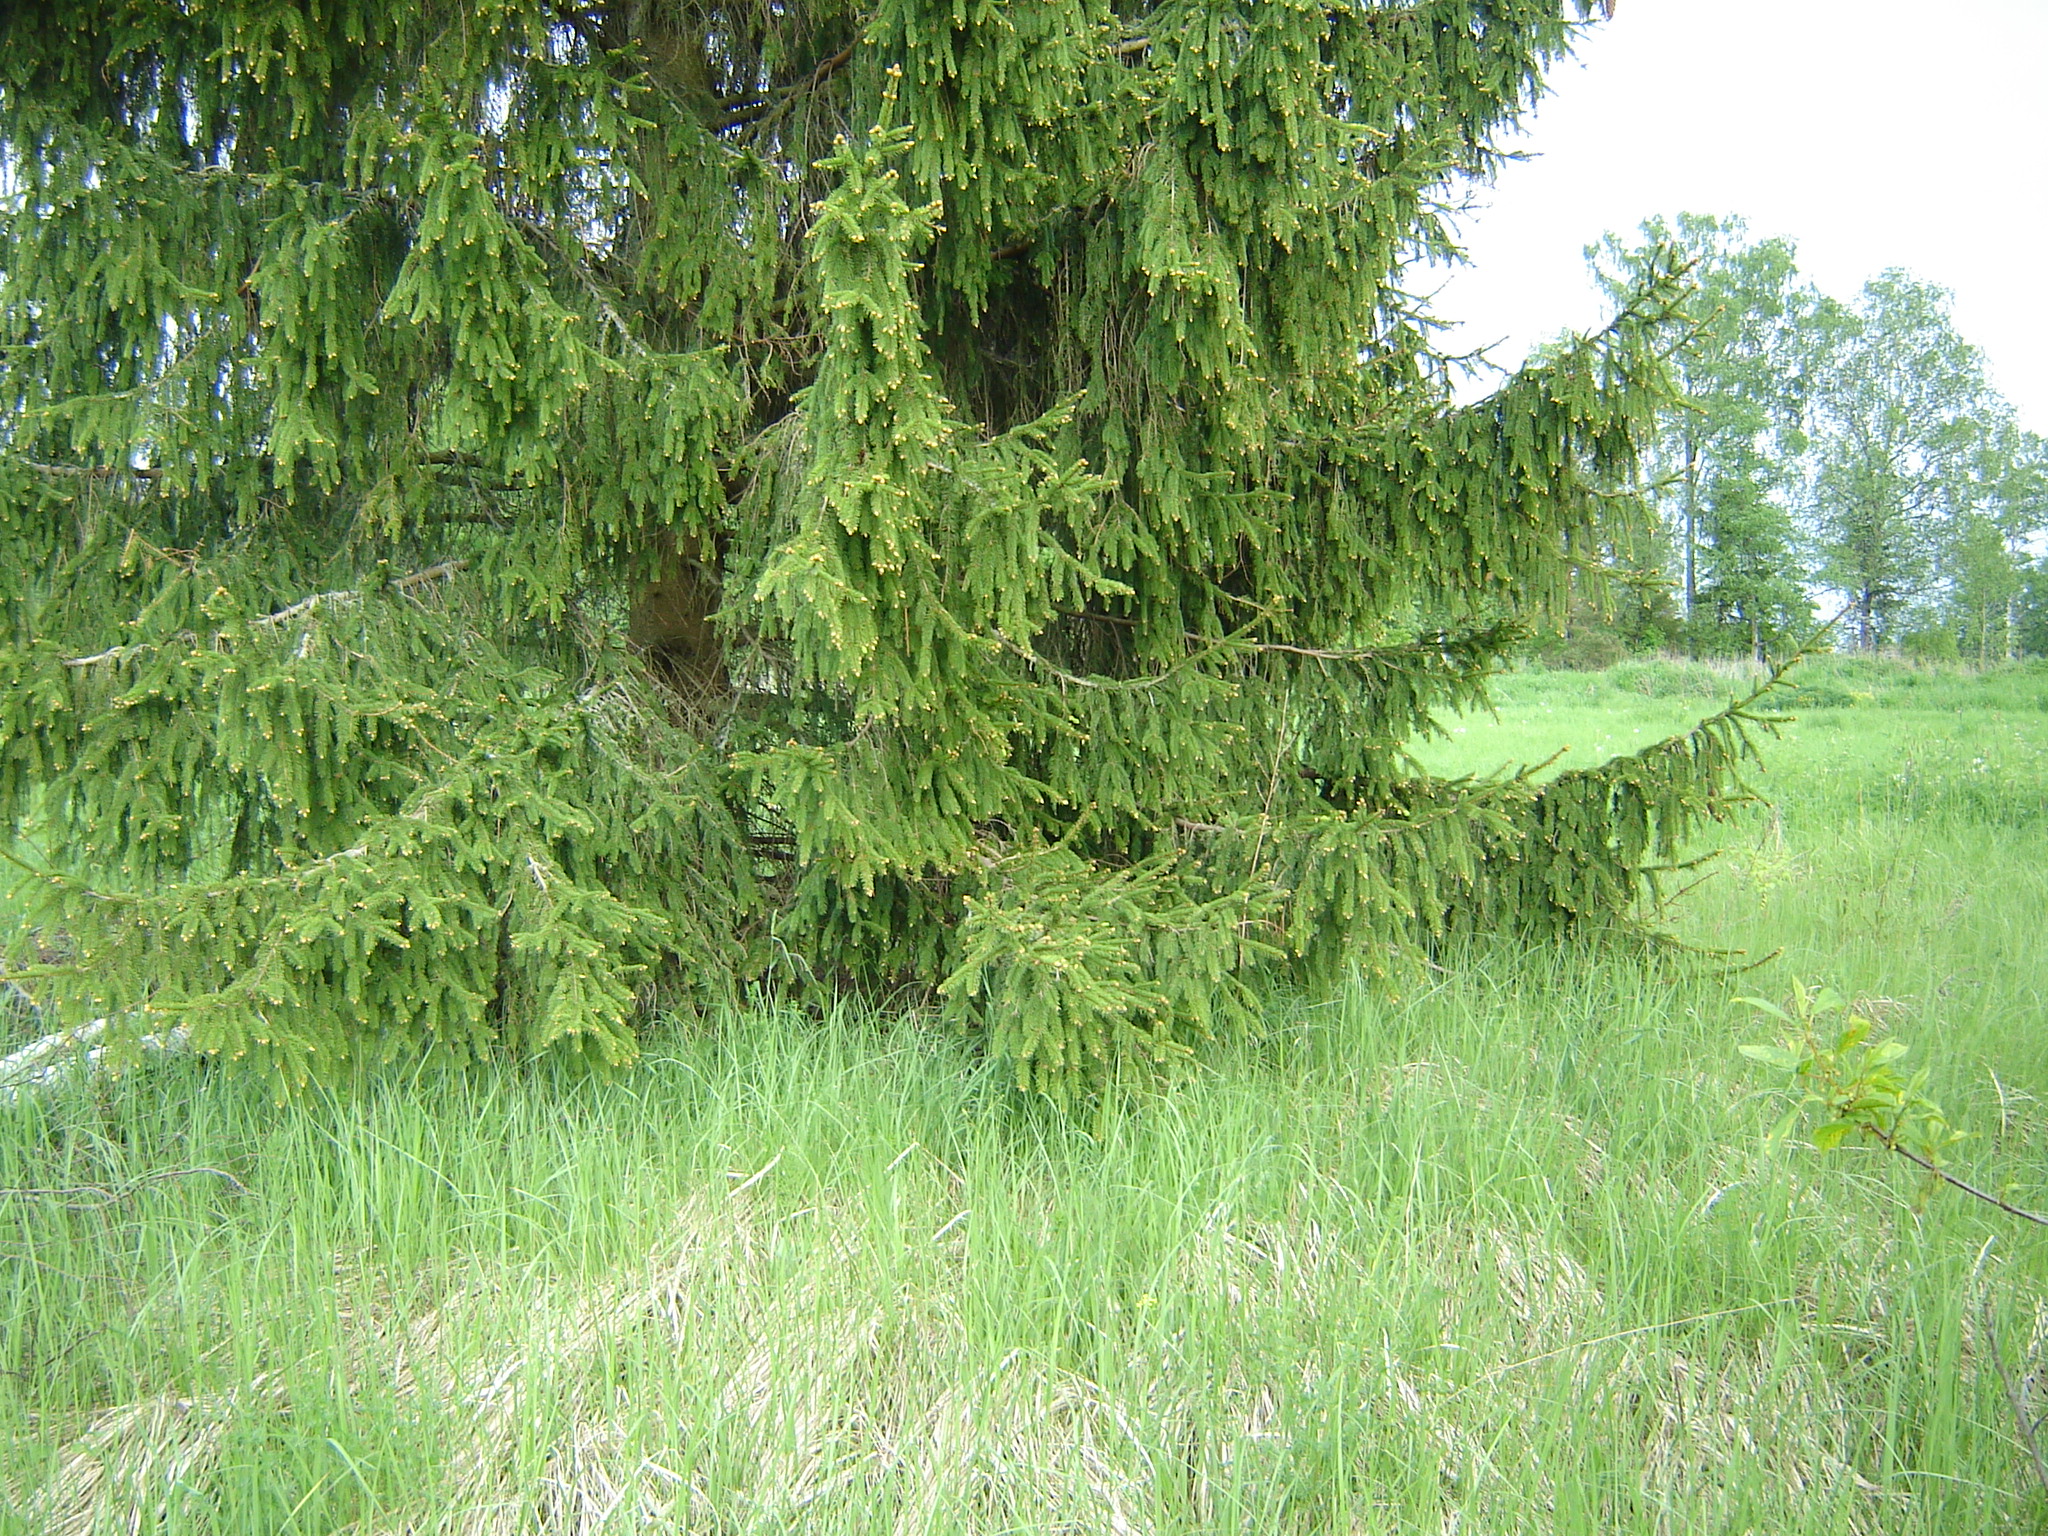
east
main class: Grassland
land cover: Grassland with sparse tree/shrub cover
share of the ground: > 75 %
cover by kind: herbaceous plants 95 %, broadleaved forest trees 5 %
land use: Semi-natural and natural areas not in use
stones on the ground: < 10 %
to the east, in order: Grassland with sparse tree/shrub cover; Electric lines; Single bushes/trees; Grassland without tree/shrub cover; Tracks; Spontaneously vegetated surfaces; Broadleaved woodland; Spruce dominated coniferous woodland; Spruce dominated mixed woodland
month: May
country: LT
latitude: 55.9980
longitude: 25.4331
